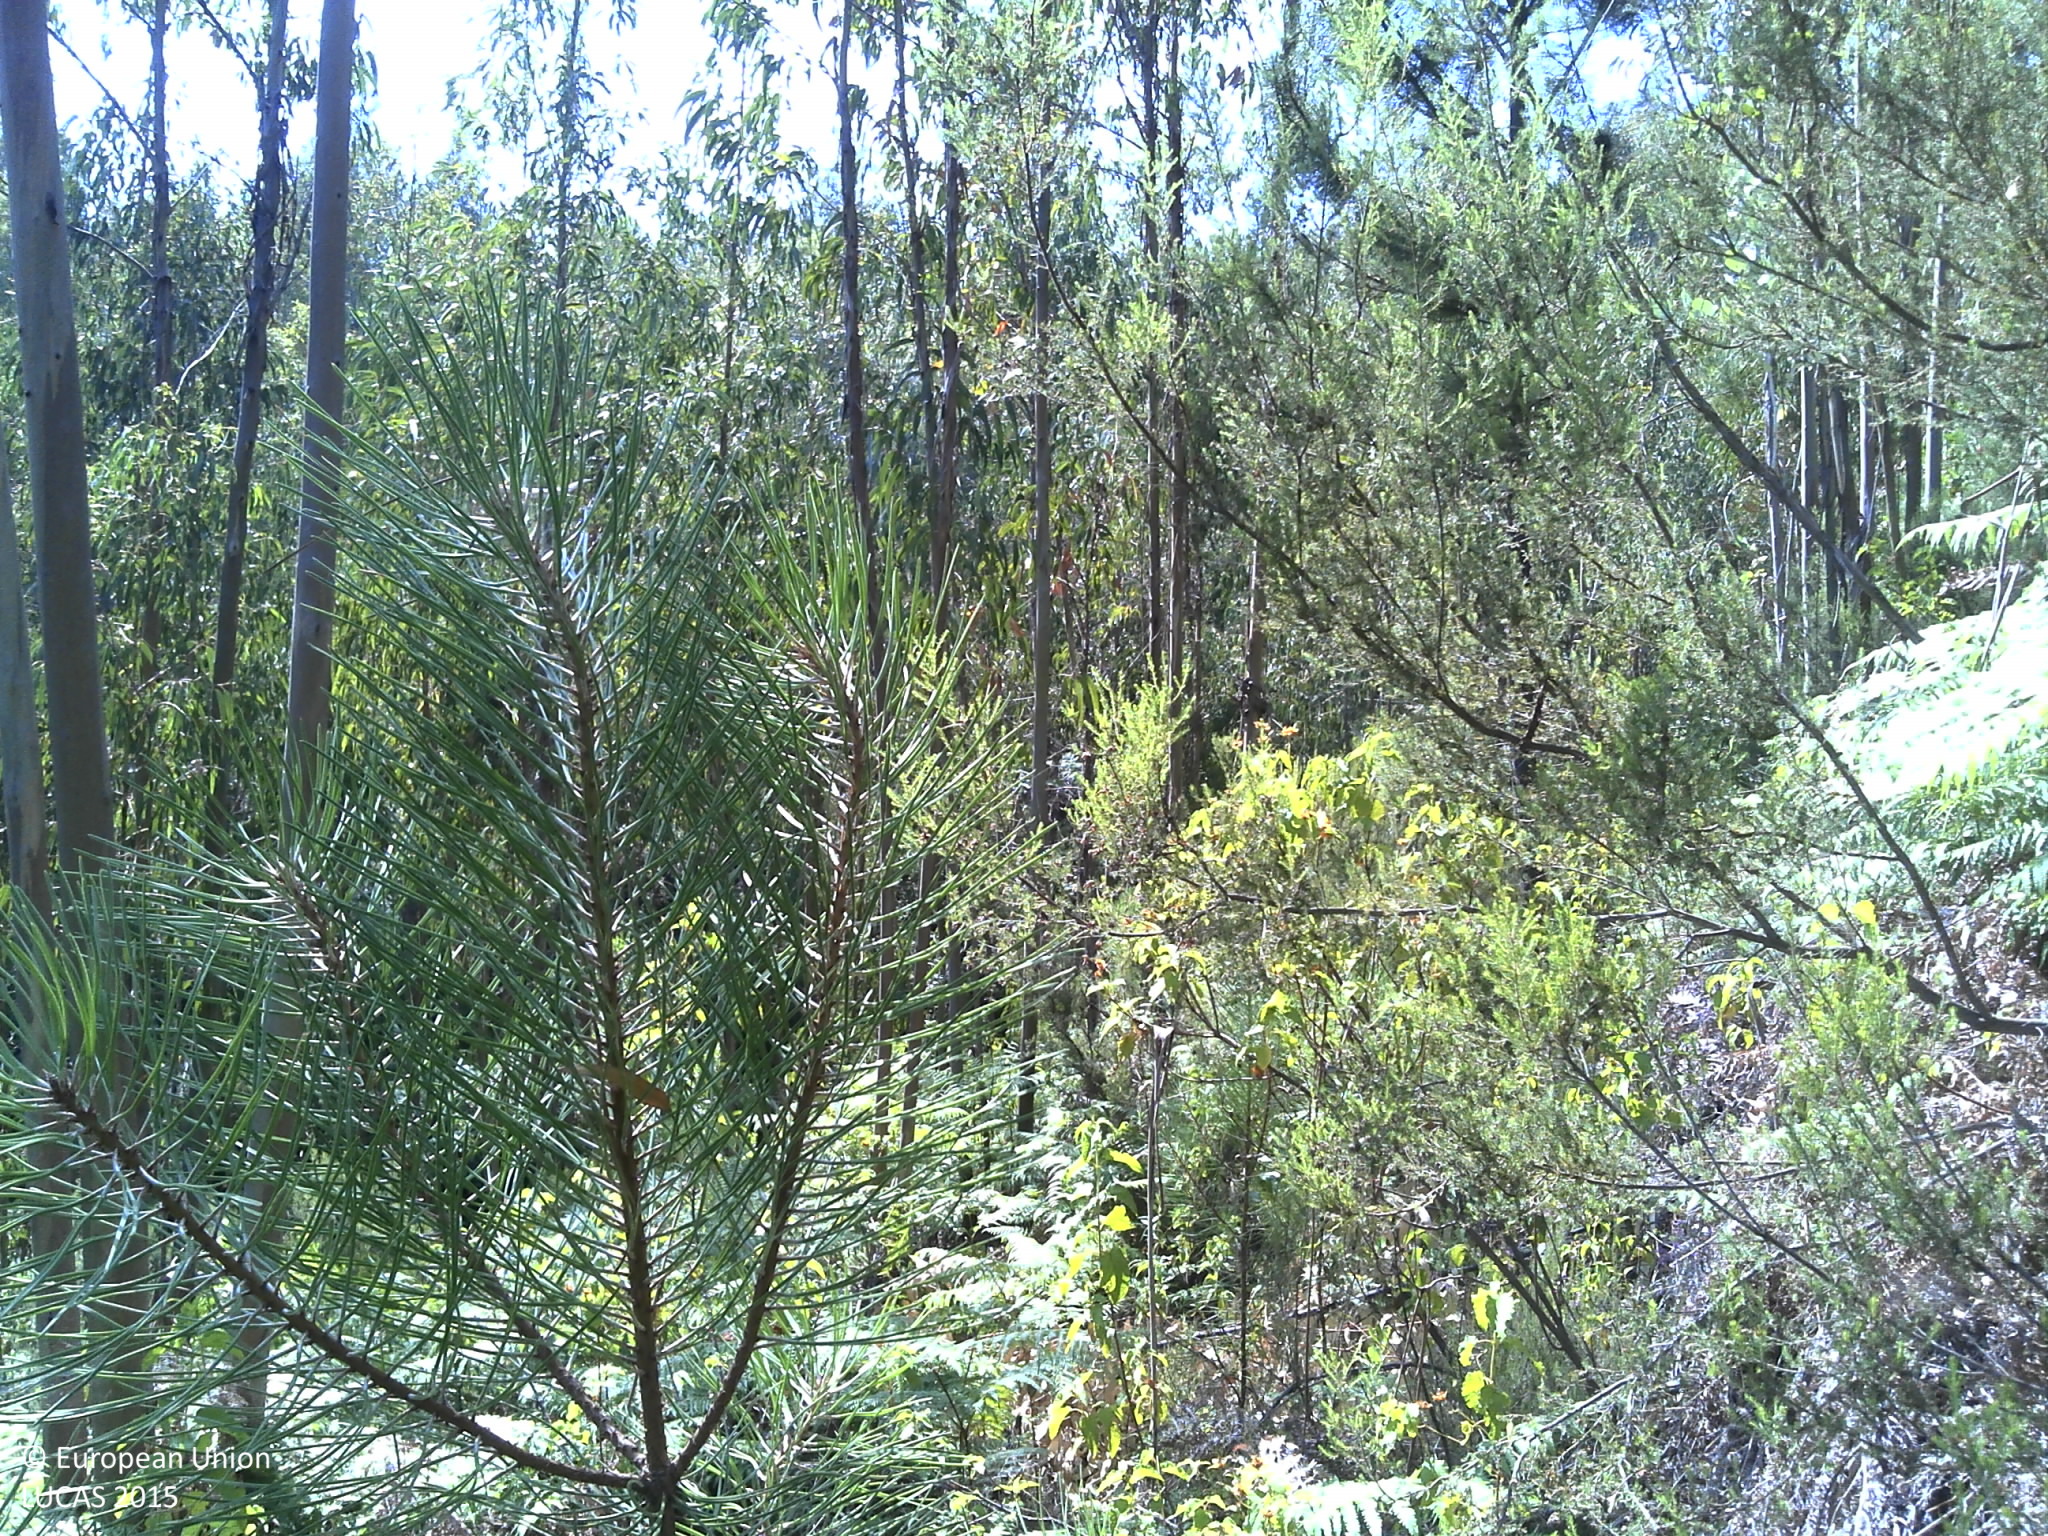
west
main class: Woodland
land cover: Broadleaved woodland
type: exotic forest
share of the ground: 10 - 25 %
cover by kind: shrubs 60 %, broadleaved forest trees 20 %, unconsolidated bare surface 20 %
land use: Forestry
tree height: > 5 m
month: June
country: PT
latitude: 39.9831
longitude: -8.0445
